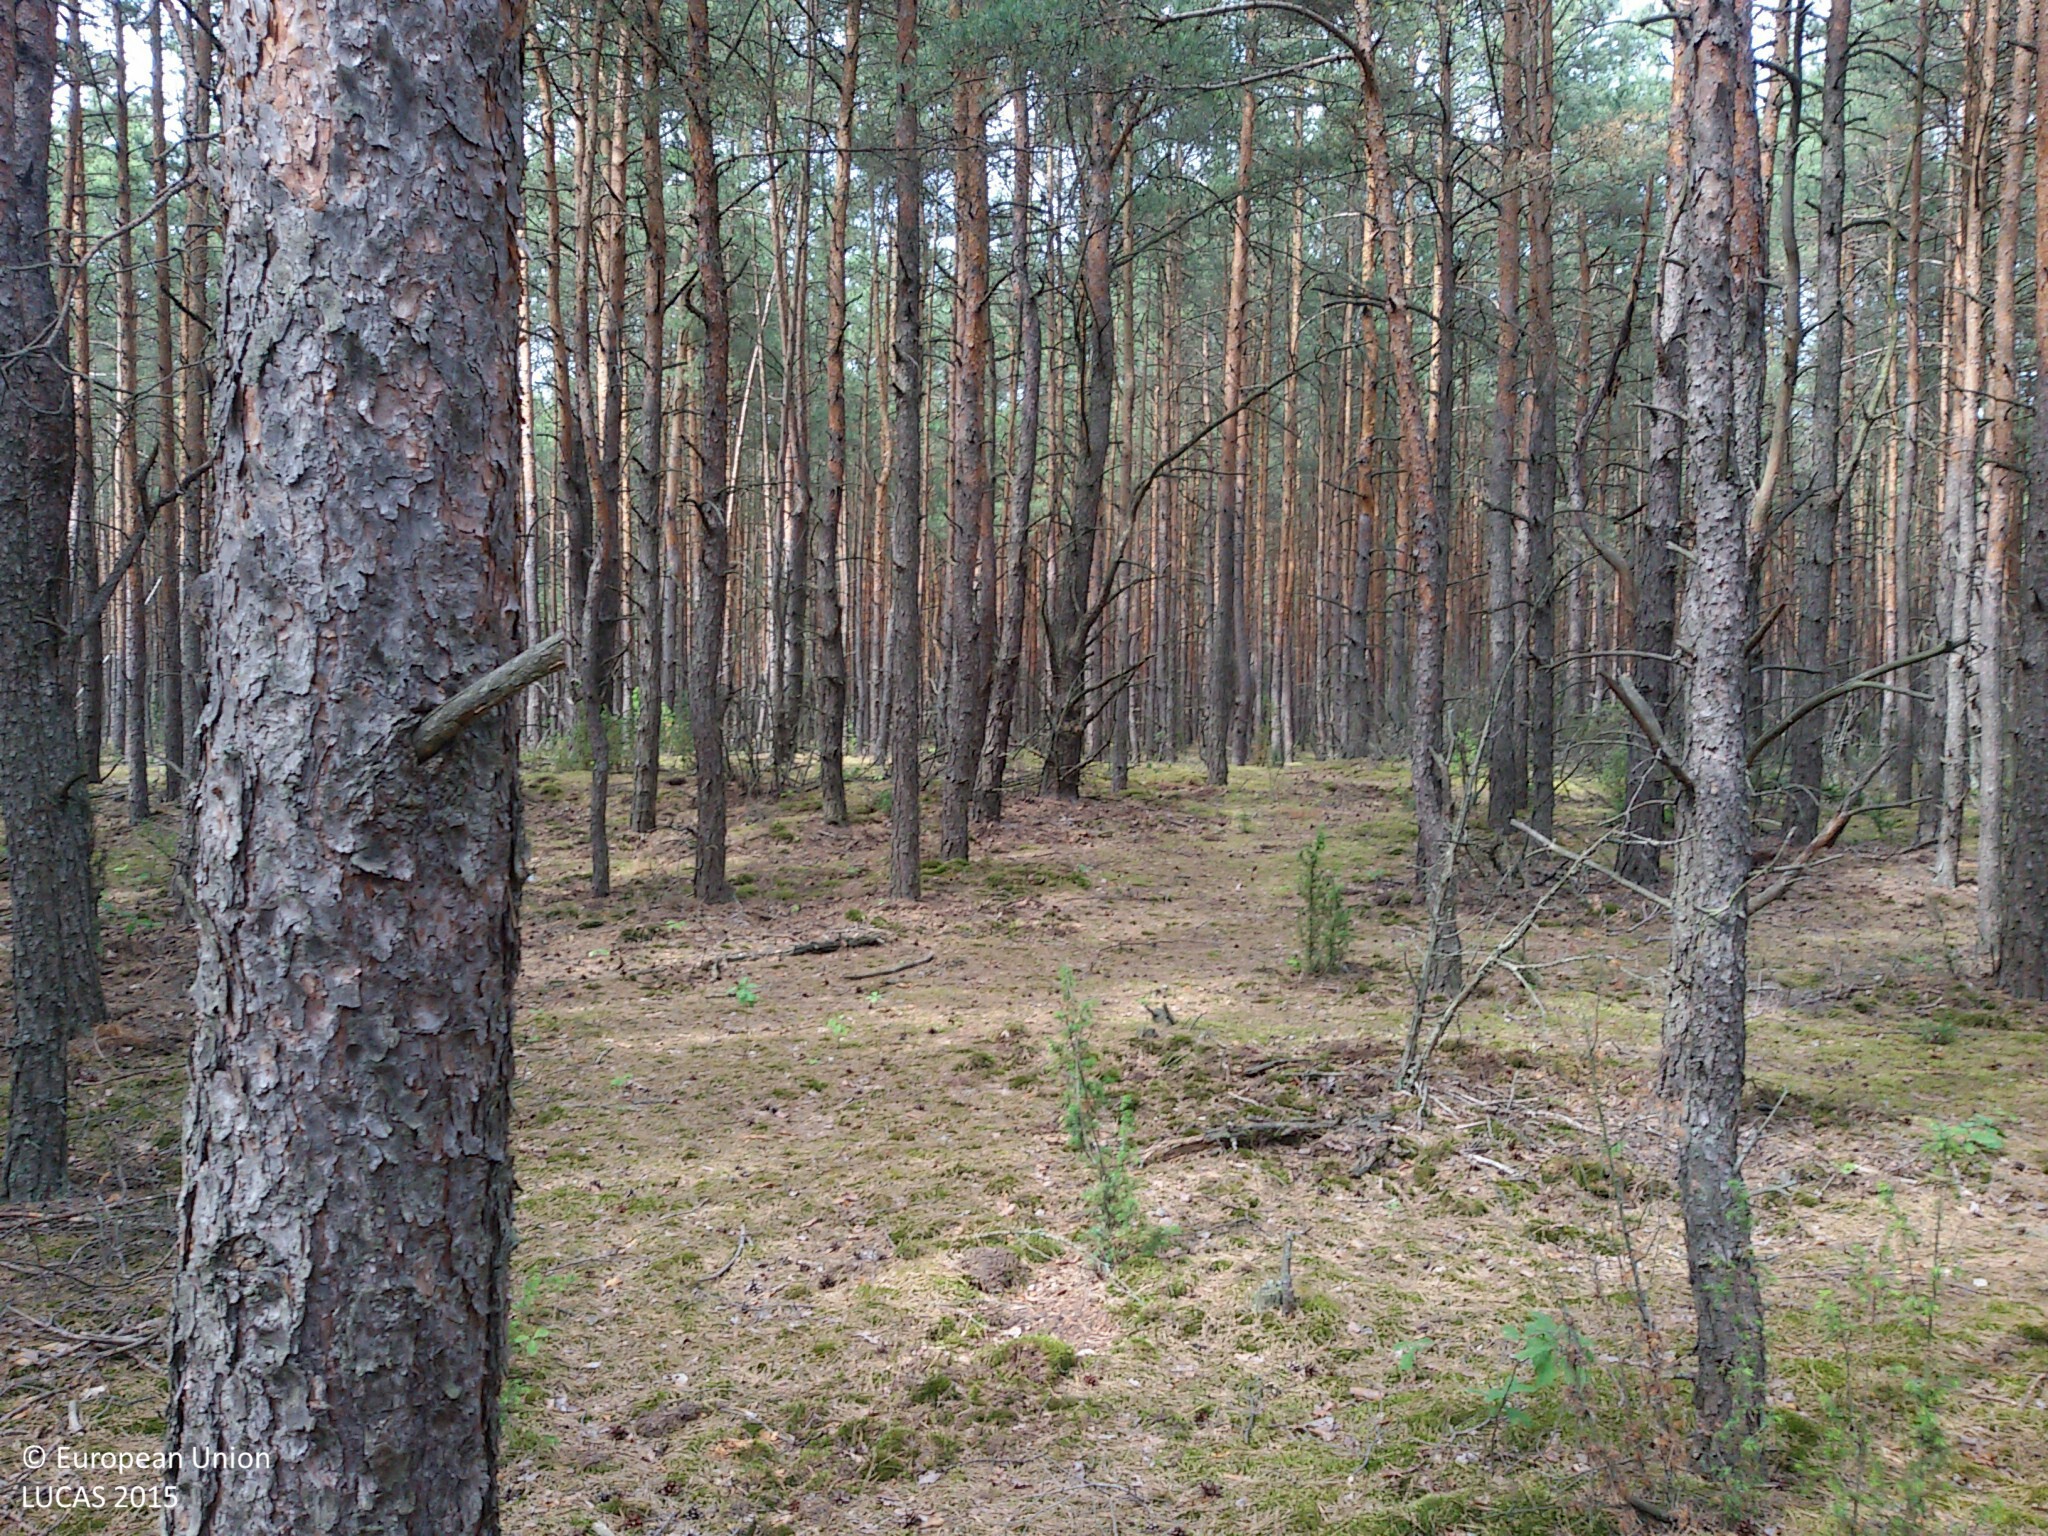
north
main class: Woodland
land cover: Pine dominated coniferous woodland
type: hemiboreal forest and nemoral coniferous forest and mixed broadleaved-coniferous forest
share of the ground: > 75 %
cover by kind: coniferous forest trees 80 %, lichens and mosses 20 %
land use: Forestry
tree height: > 5 m
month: June
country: PL
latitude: 52.2836
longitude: 20.7865
